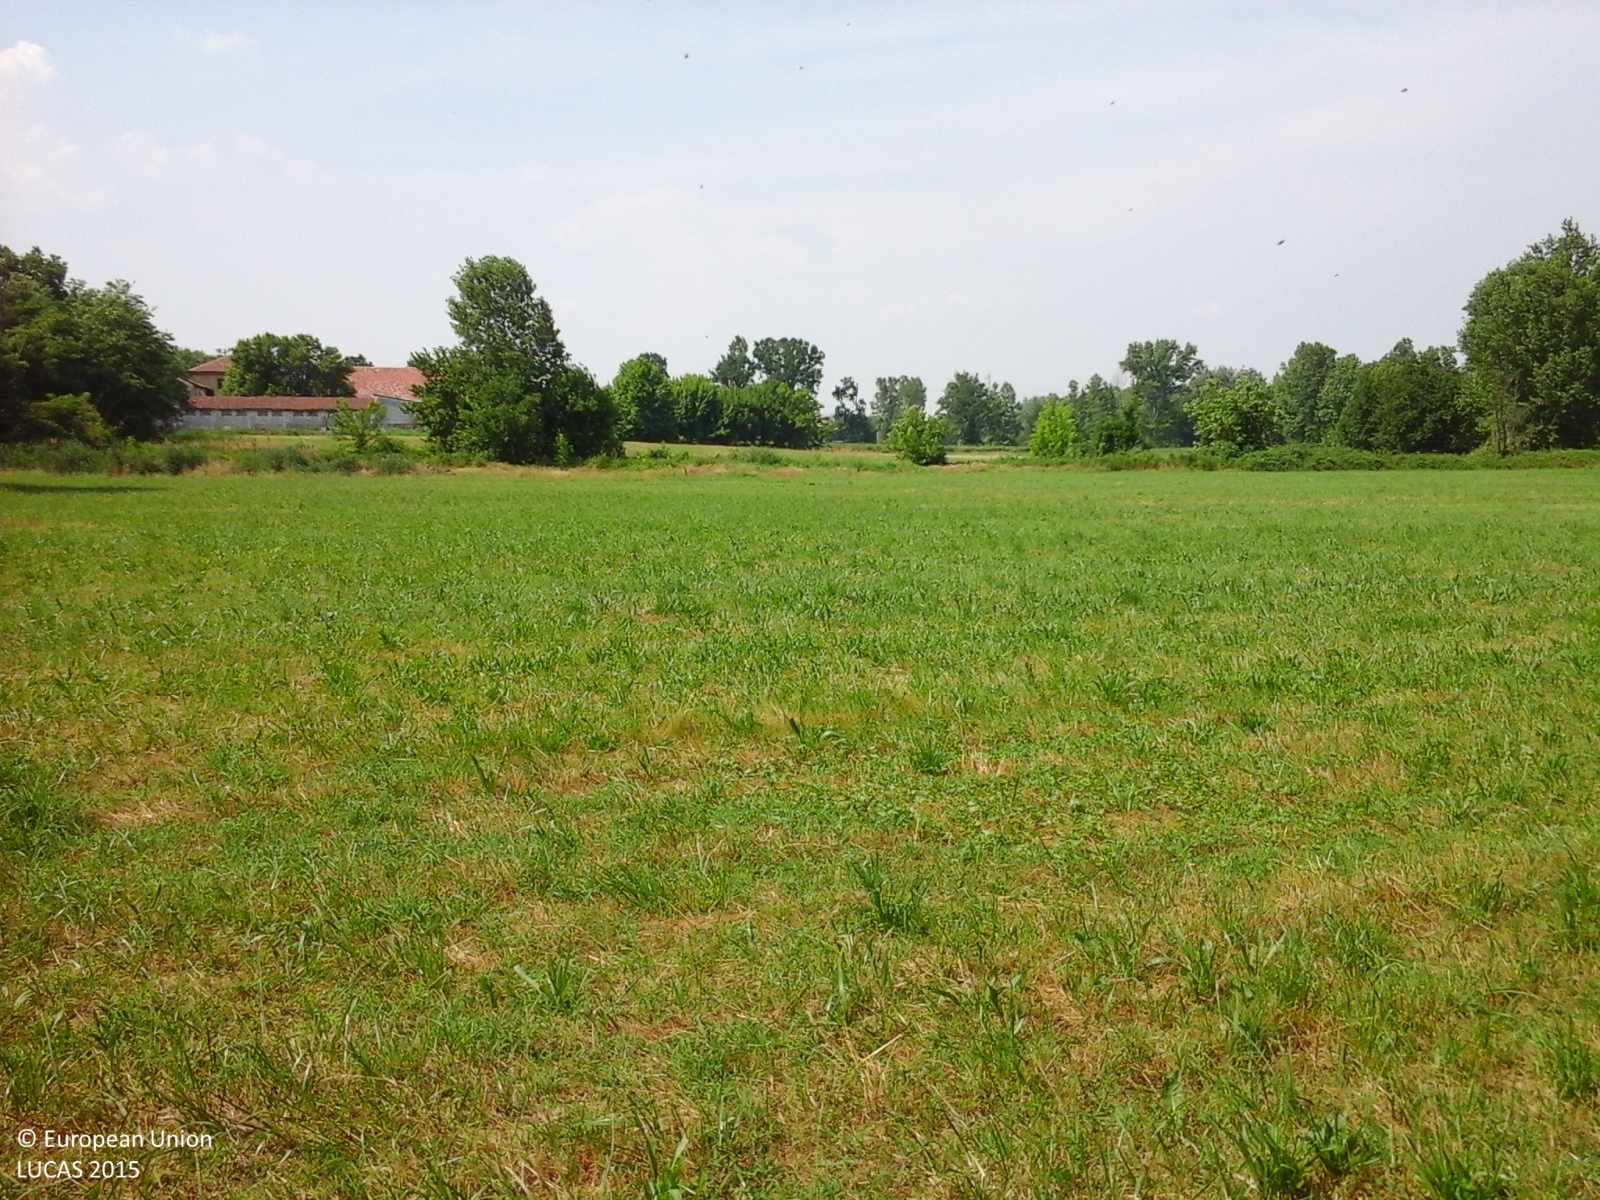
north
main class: Grassland
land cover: Grassland without tree/shrub cover
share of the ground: > 75 %
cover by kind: herbaceous plants 100 %
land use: Agriculture (excluding fallow land and kitchen gardens)
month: June
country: IT
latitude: 45.1614
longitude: 9.6572
